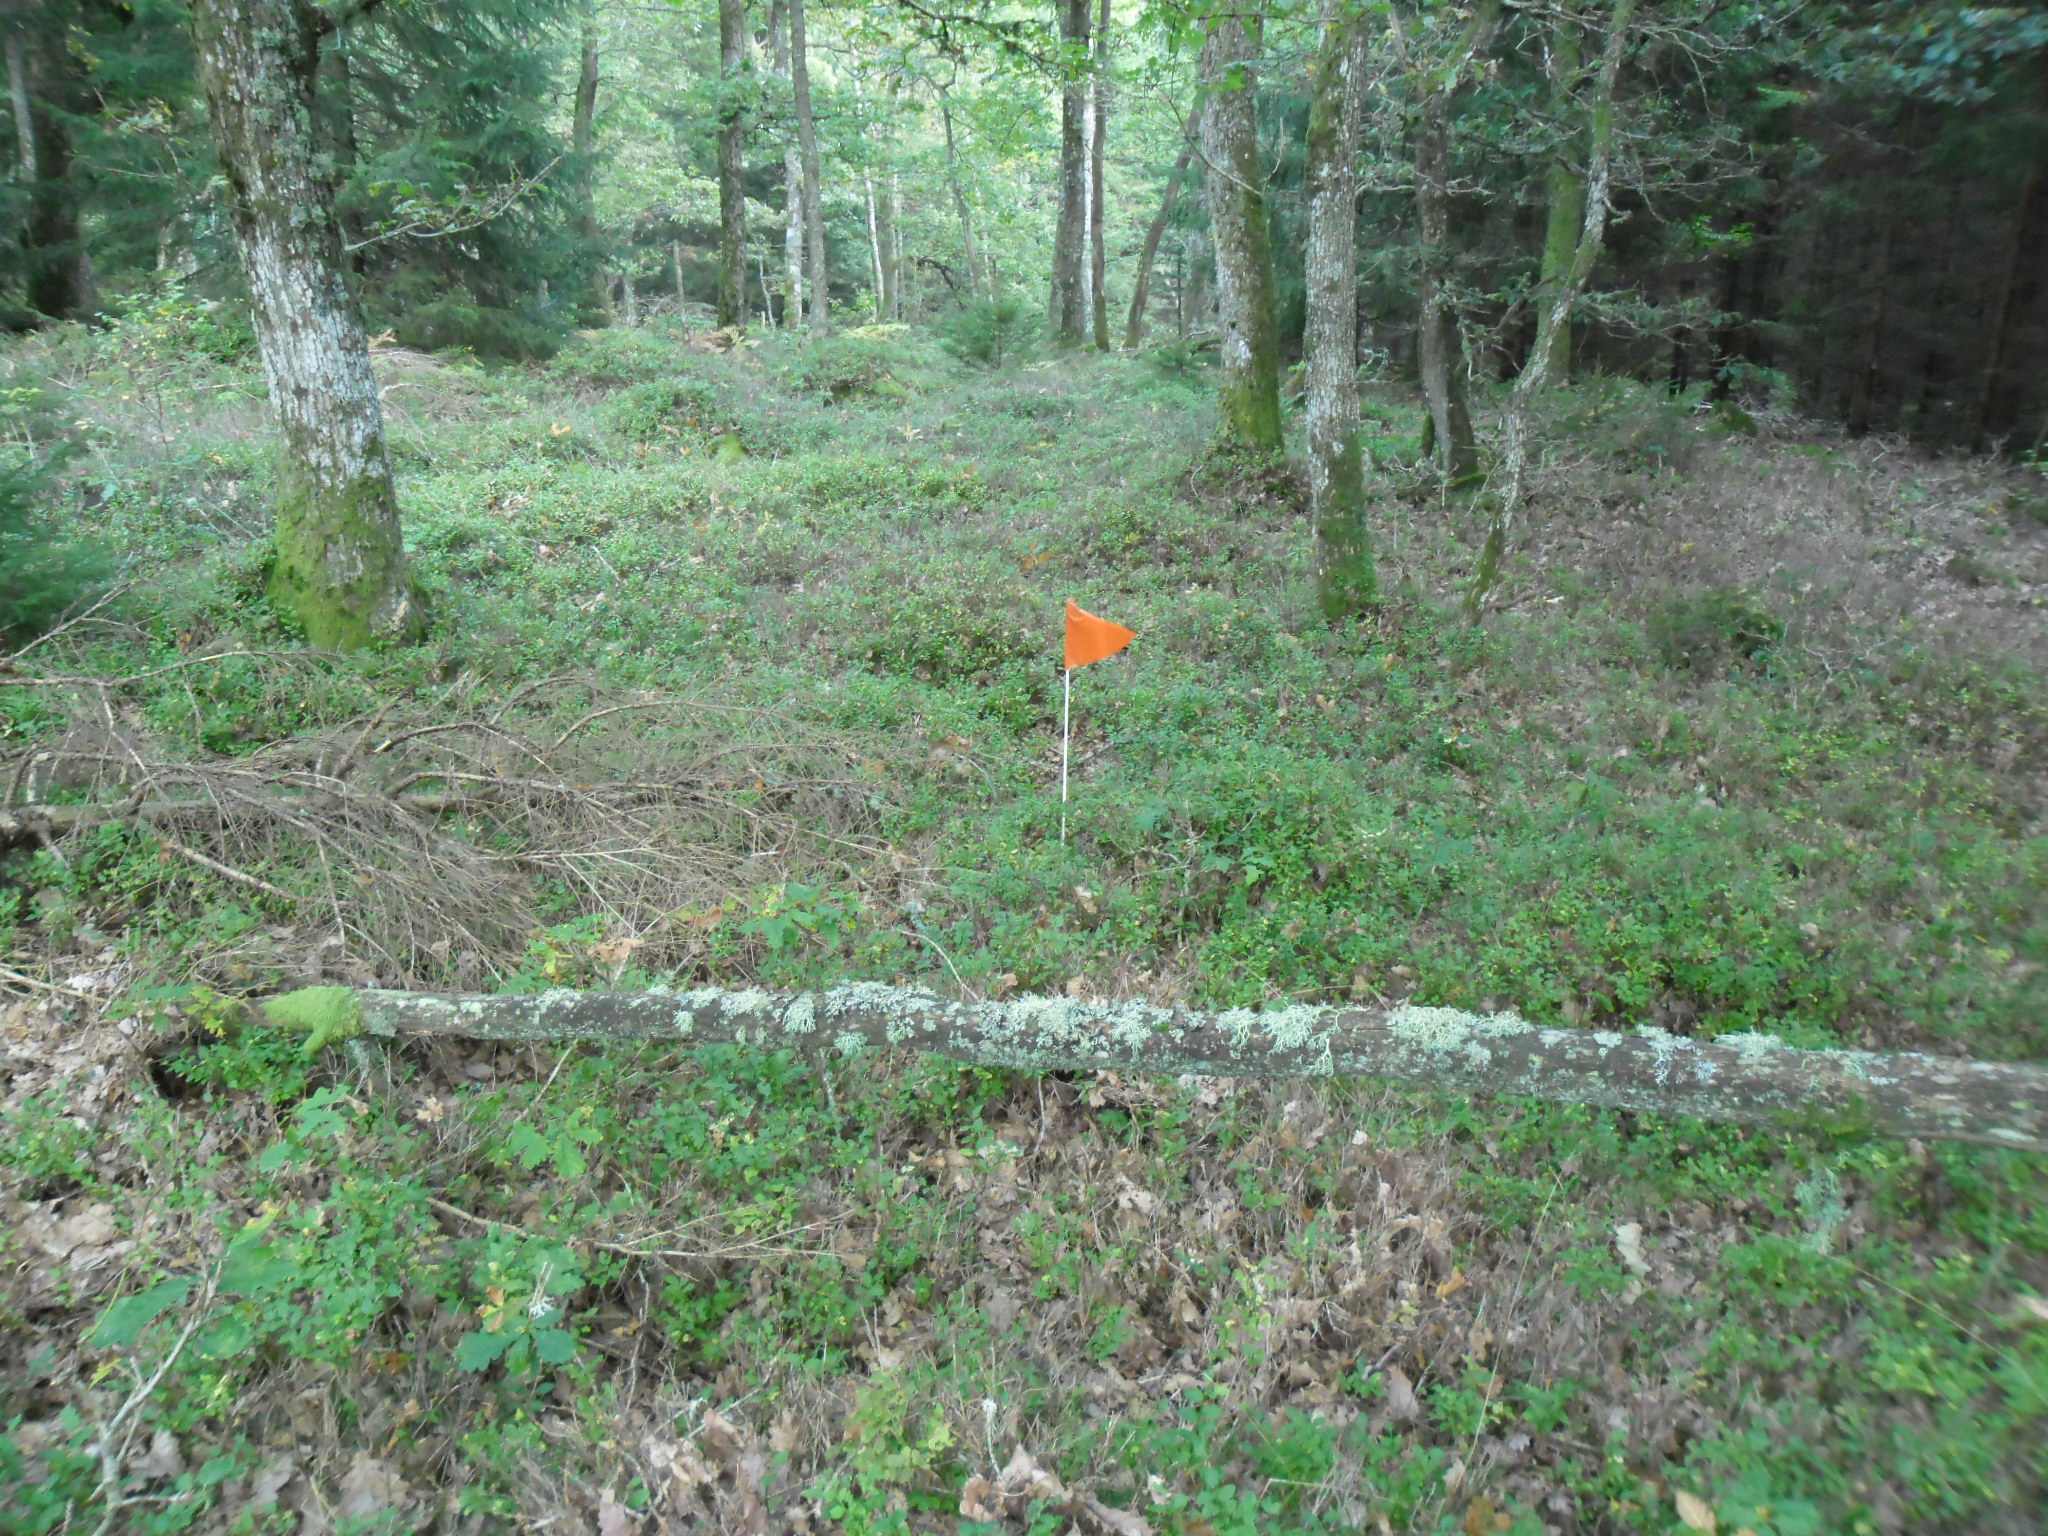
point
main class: Woodland
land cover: Broadleaved woodland
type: acidophilous oak and oak-birch forest
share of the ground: > 75 %
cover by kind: broadleaved forest trees 100 %
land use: Forestry
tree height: > 5 m
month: October
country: SE
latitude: 56.6171
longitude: 13.1419
